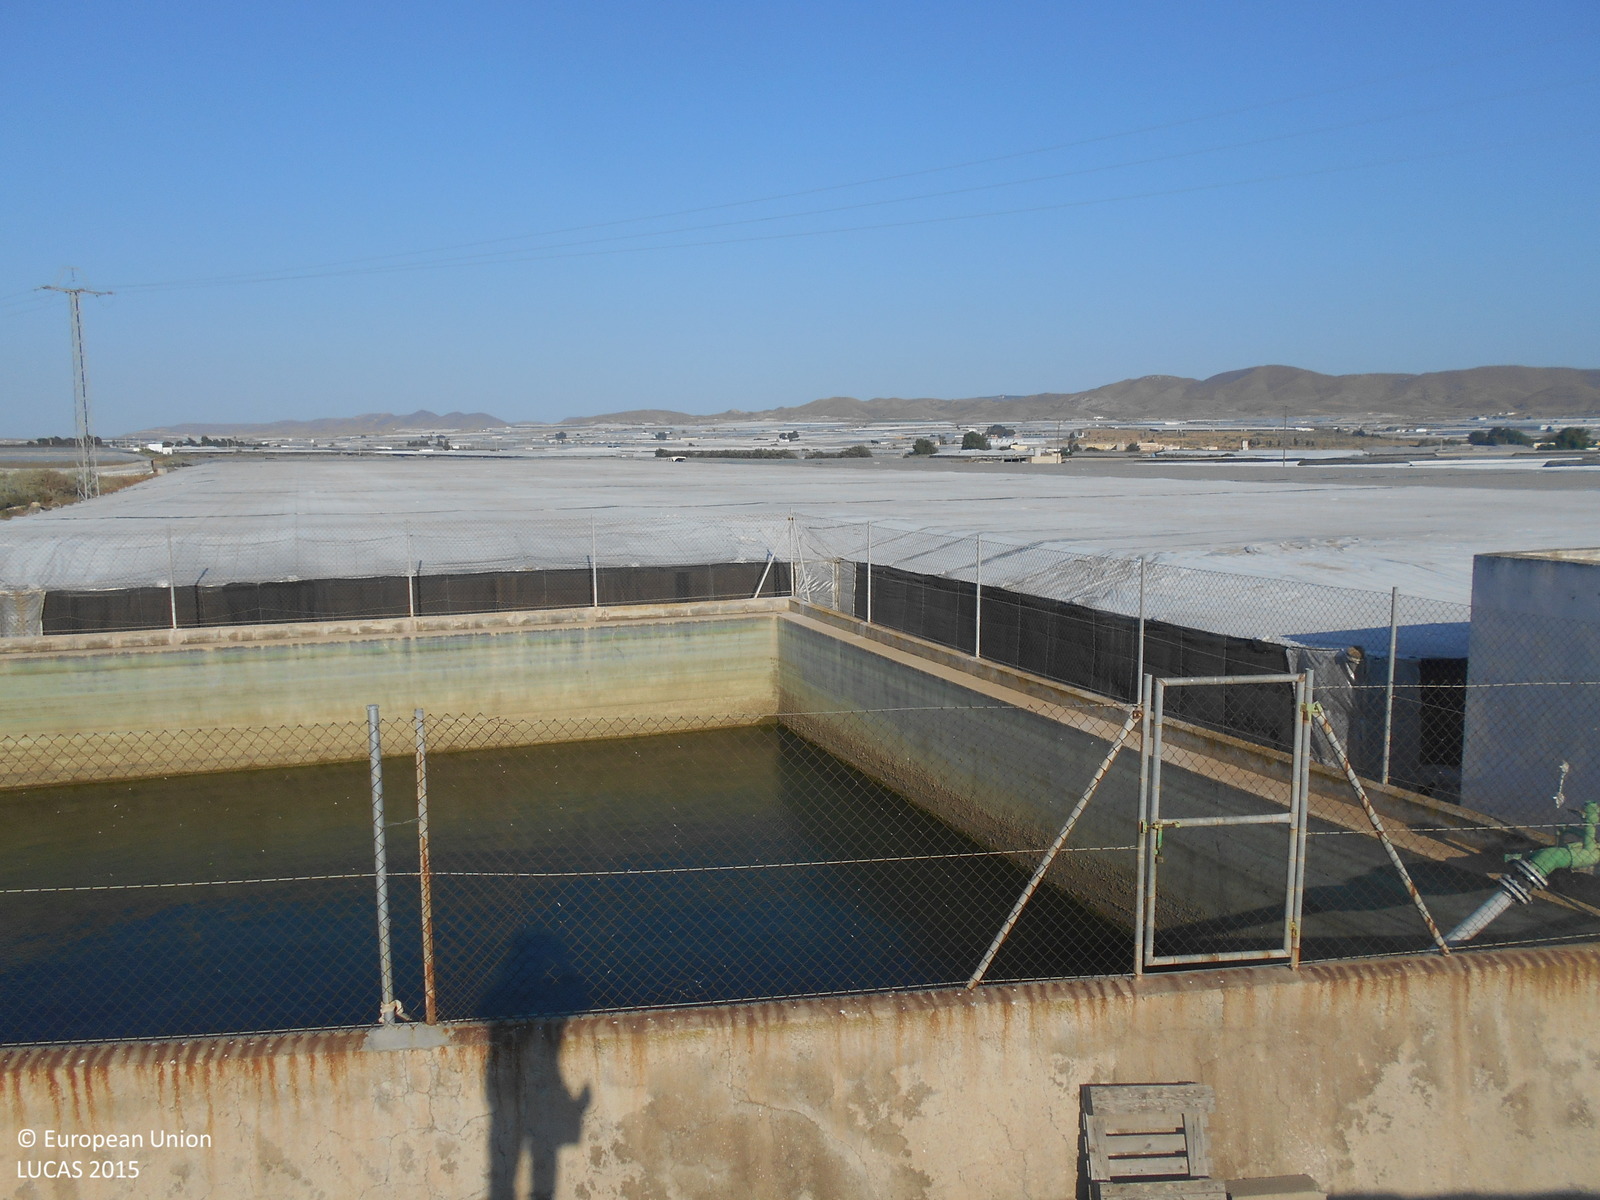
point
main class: Artificial land
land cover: Greenhouses
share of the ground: > 75 %
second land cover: Other fresh vegetables
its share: > 75 %
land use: Agriculture (excluding fallow land and kitchen gardens)
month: May
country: ES
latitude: 36.9309
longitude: -2.1333
